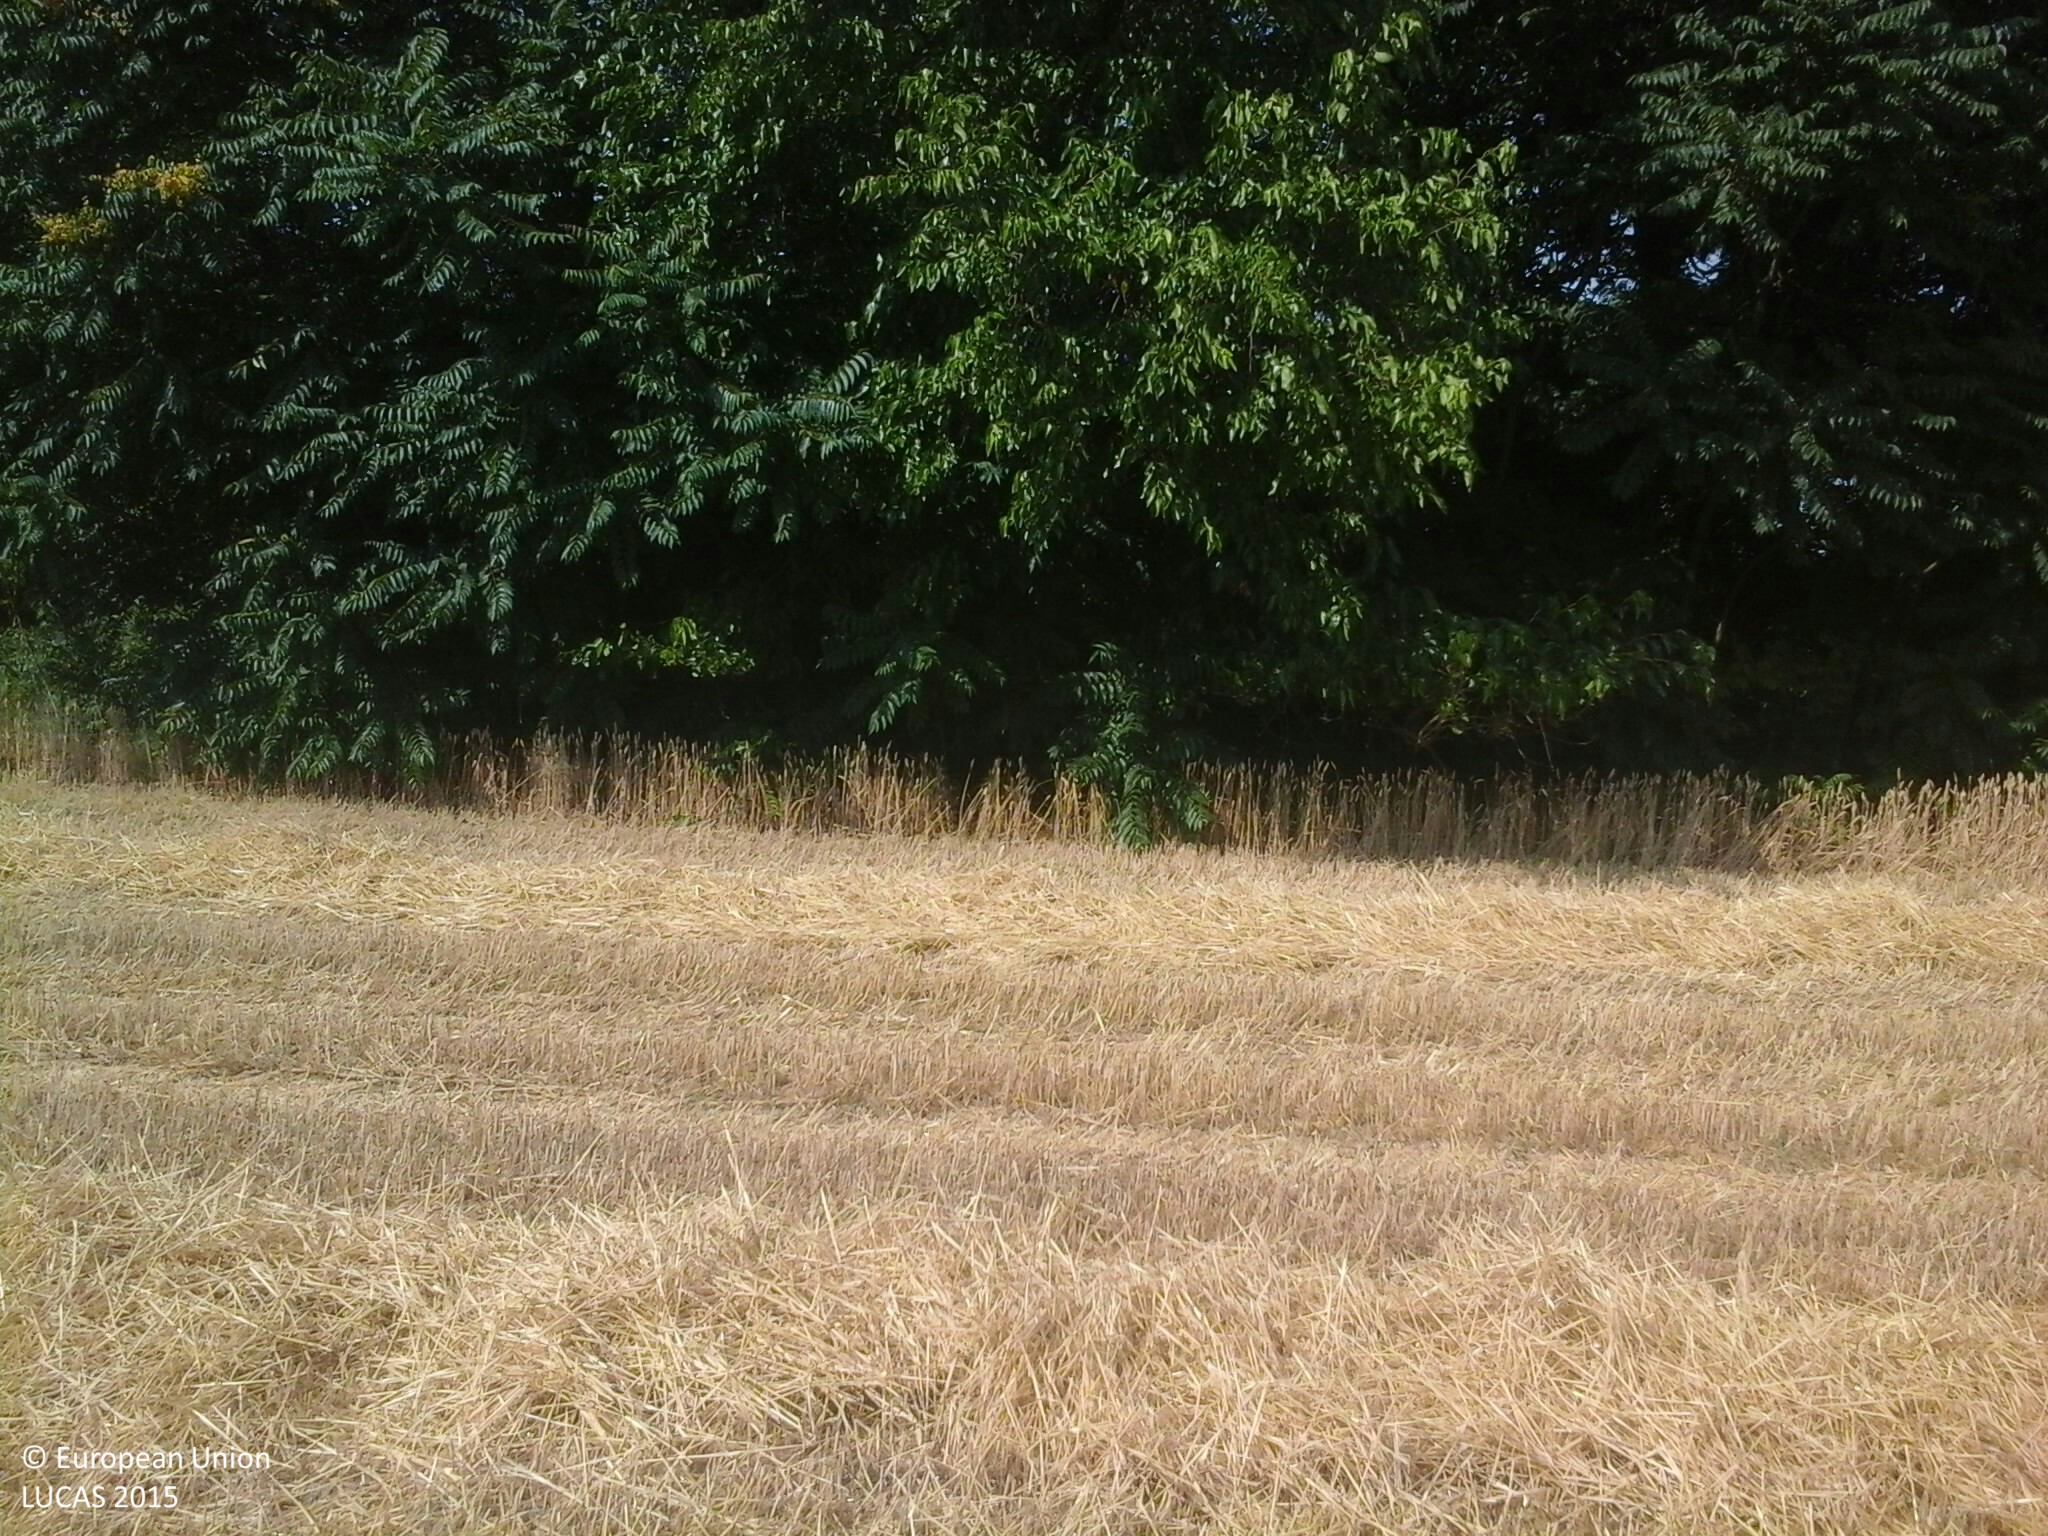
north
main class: Cropland
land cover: Common wheat
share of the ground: > 75 %
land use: Agriculture (excluding fallow land and kitchen gardens)
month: July
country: HU
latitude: 47.2225
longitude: 18.9831
